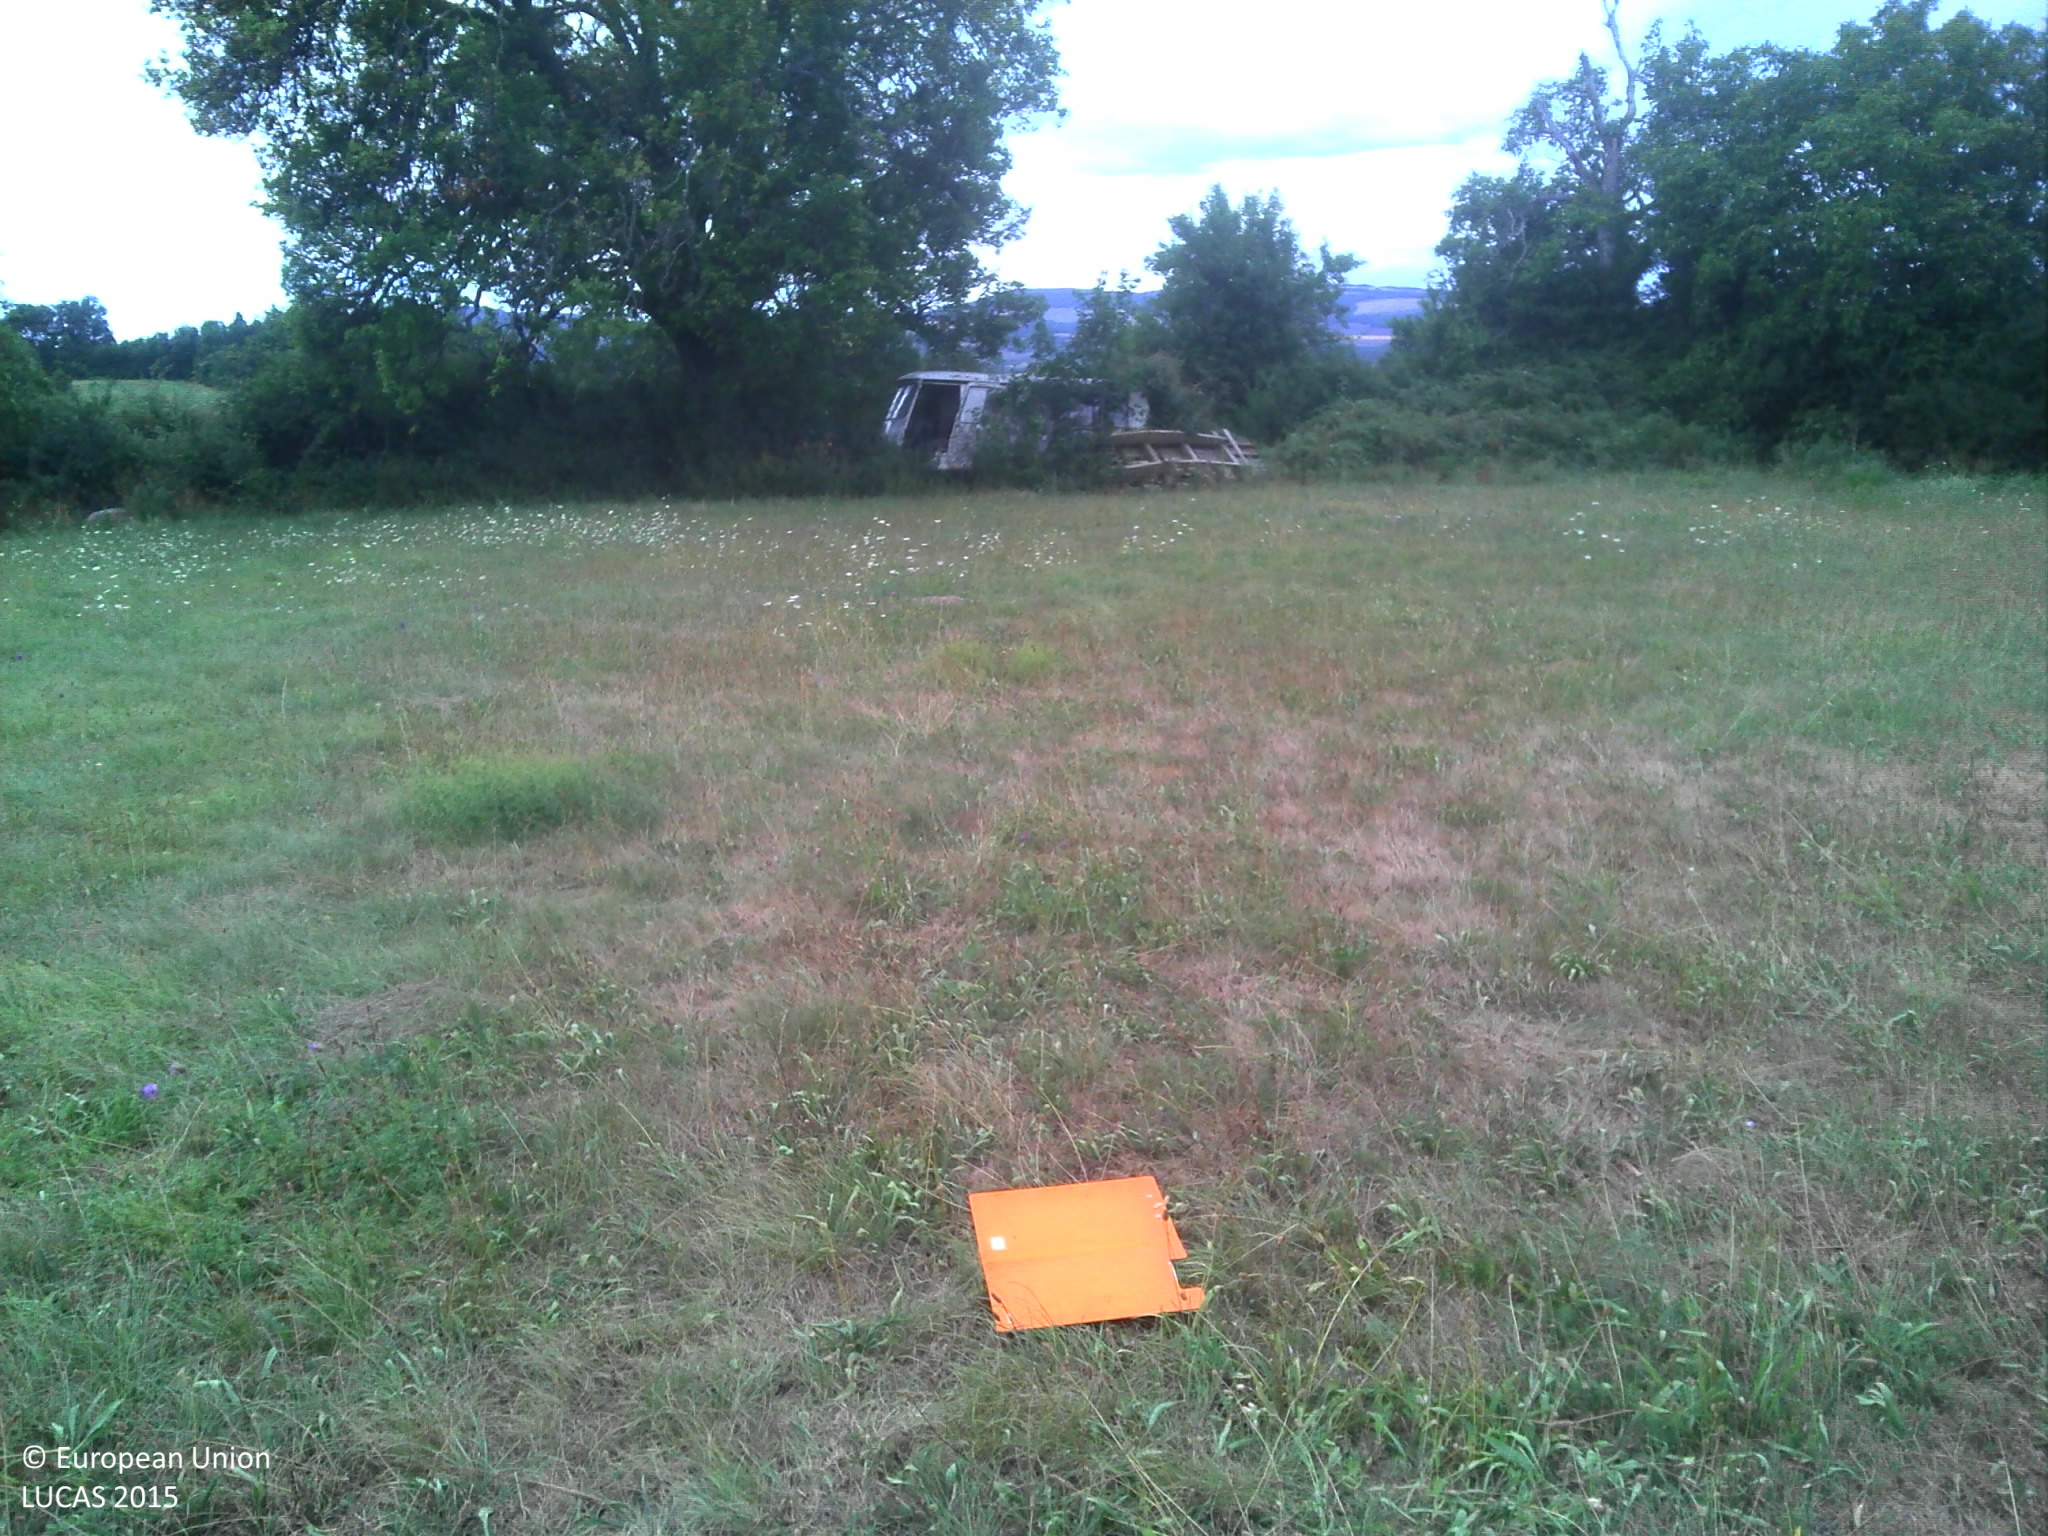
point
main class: Grassland
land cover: Grassland without tree/shrub cover
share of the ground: > 75 %
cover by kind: herbaceous plants 100 %
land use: Agriculture (excluding fallow land and kitchen gardens)
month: July
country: FR
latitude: 44.0385
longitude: 5.5532
